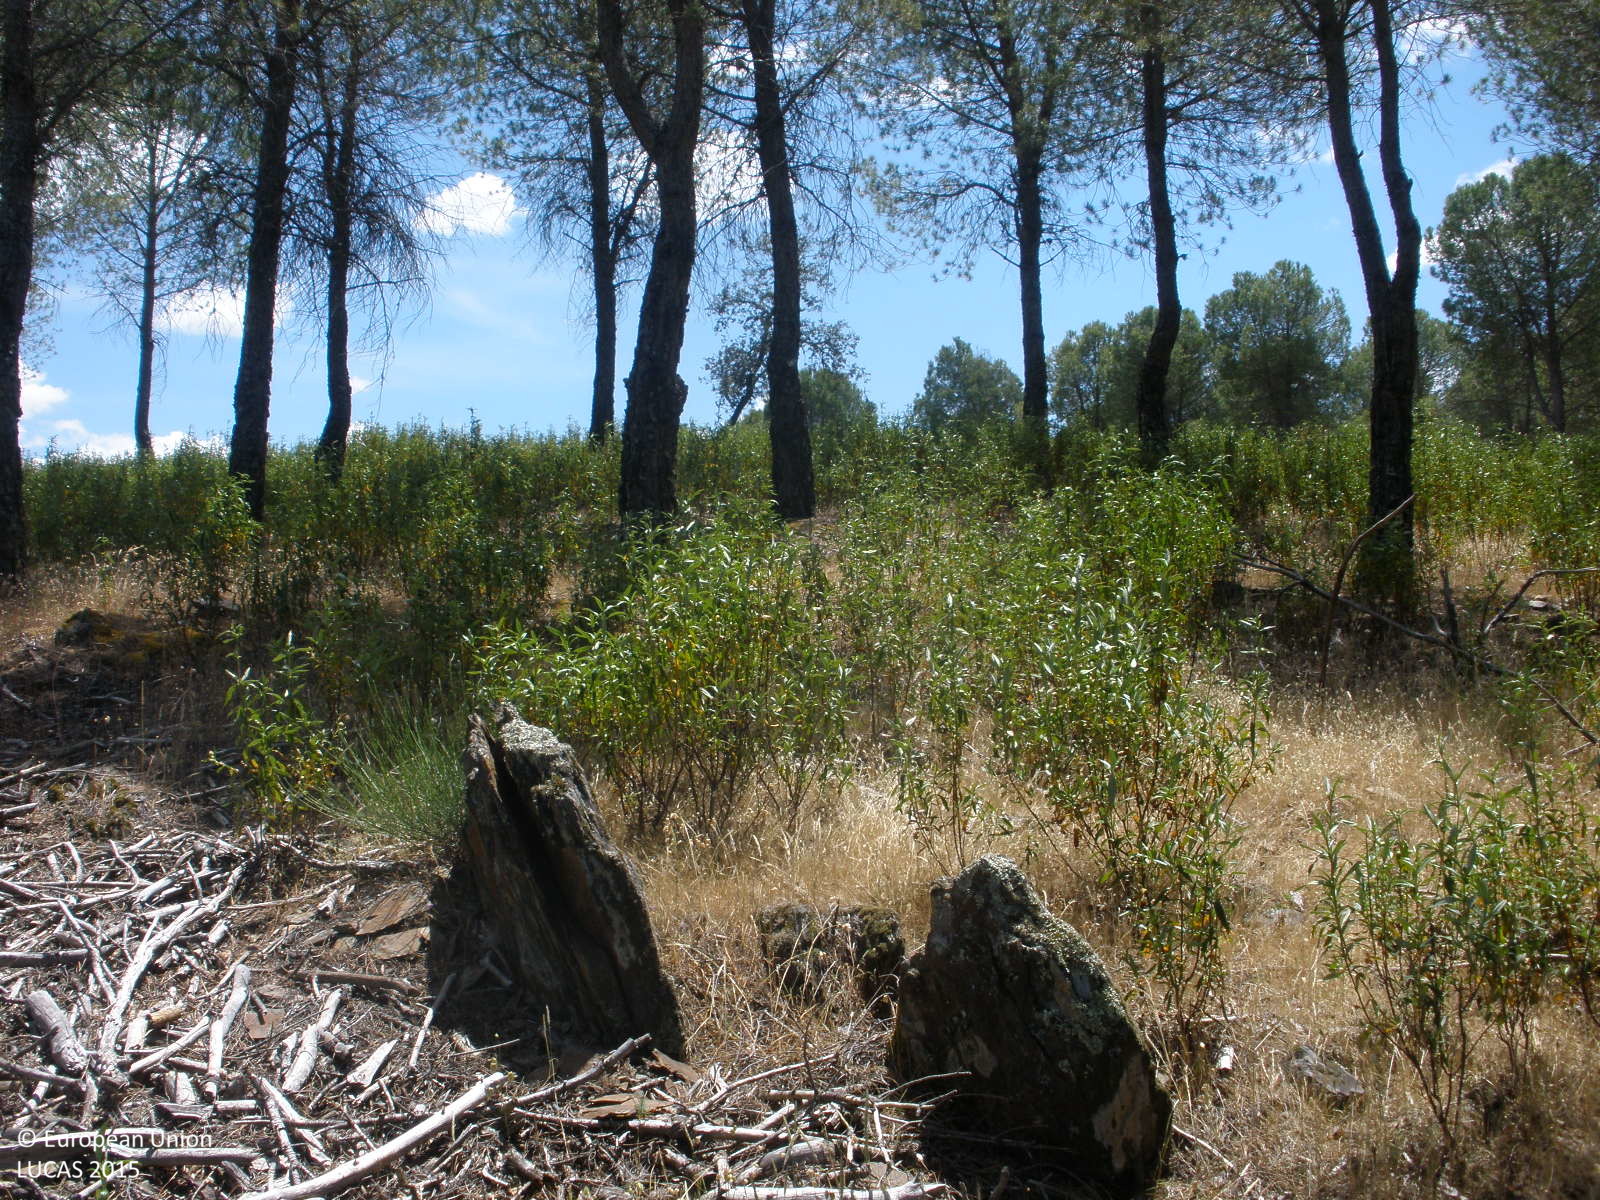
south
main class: Woodland
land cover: Pine dominated coniferous woodland
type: coniferous forest of the mediterranean region
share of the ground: 50 - 75 %
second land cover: Shrubland without tree cover
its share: 10 - 25 %
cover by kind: coniferous forest trees 50 %, shrubs 30 %, herbaceous plants 20 %
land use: Forestry
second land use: Agriculture (excluding fallow land and kitchen gardens)
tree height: > 5 m
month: May
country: ES
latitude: 40.2743
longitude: -6.0812
